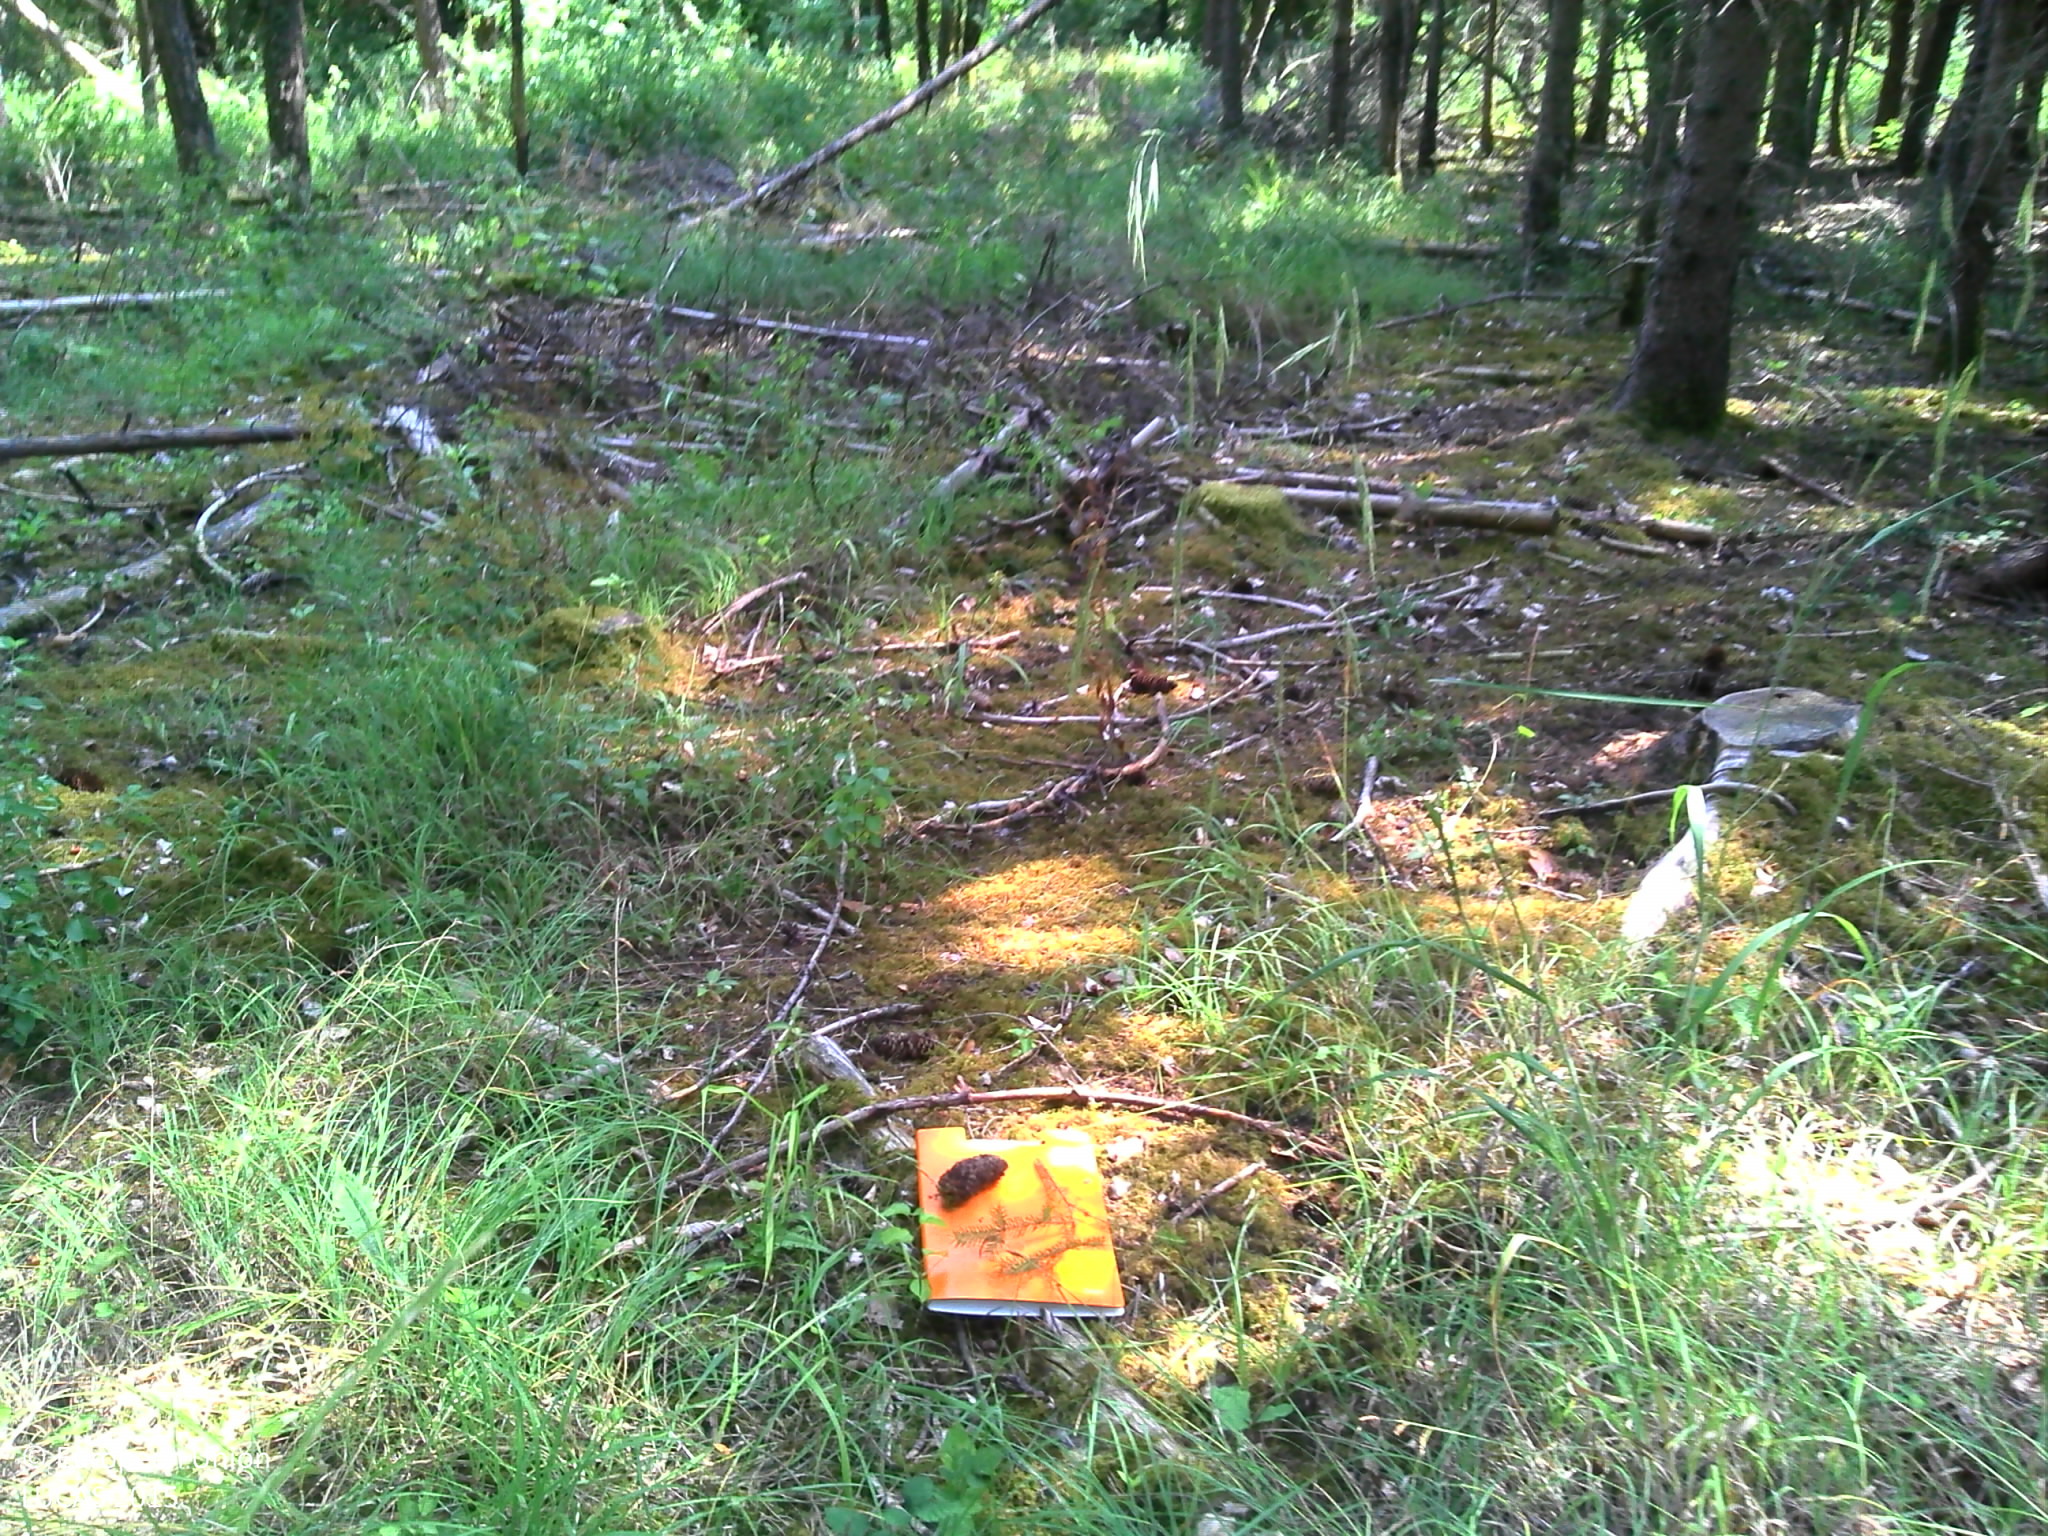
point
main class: Woodland
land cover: Spruce dominated coniferous woodland
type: alpine coniferous forest
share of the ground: > 75 %
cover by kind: coniferous forest trees 60 %, broadleaved forest trees 20 %, herbaceous plants 10 %, lichens and mosses 10 %
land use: Forestry
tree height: > 5 m
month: July
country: FR
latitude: 48.0805
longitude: 4.7499
